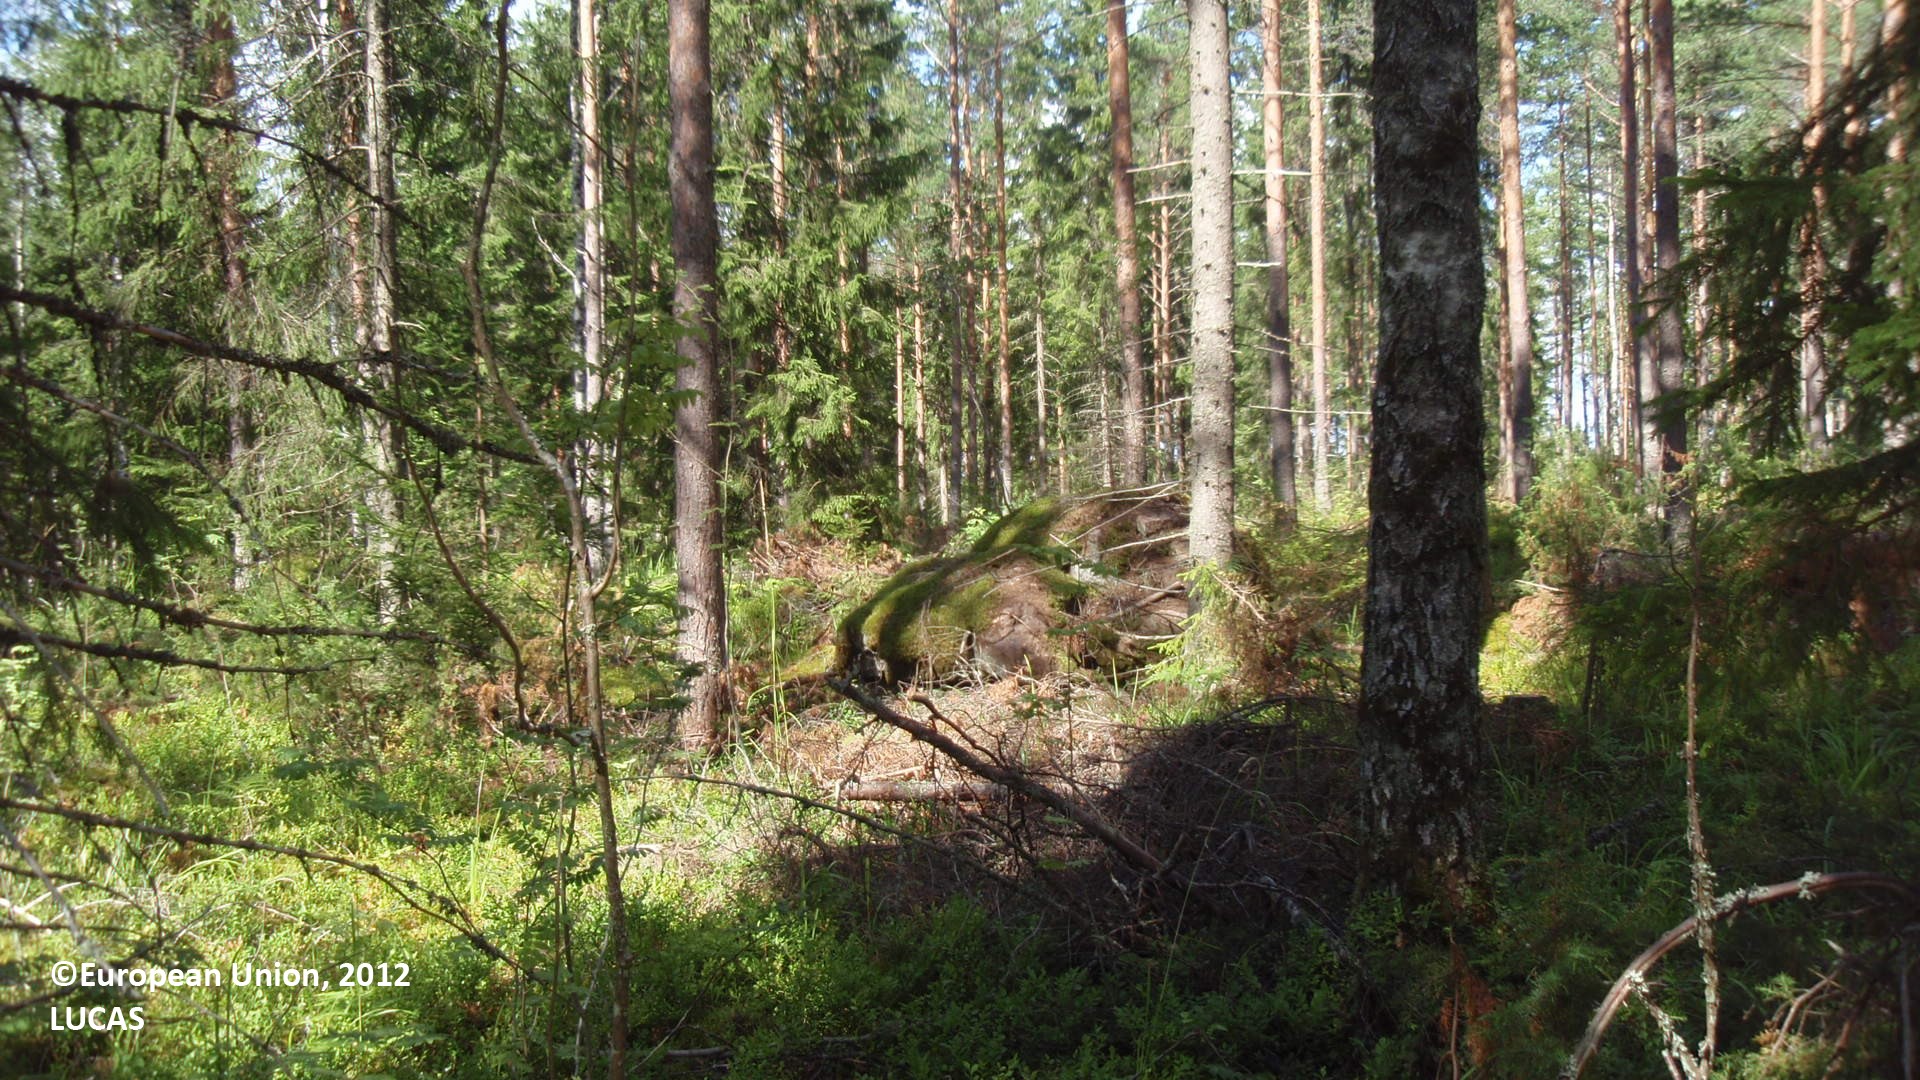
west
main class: Woodland
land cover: Pine dominated coniferous woodland
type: boreal forest
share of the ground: 50 - 75 %
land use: Forestry
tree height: > 5 m
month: August
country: FI
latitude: 61.0831
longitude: 28.0149
